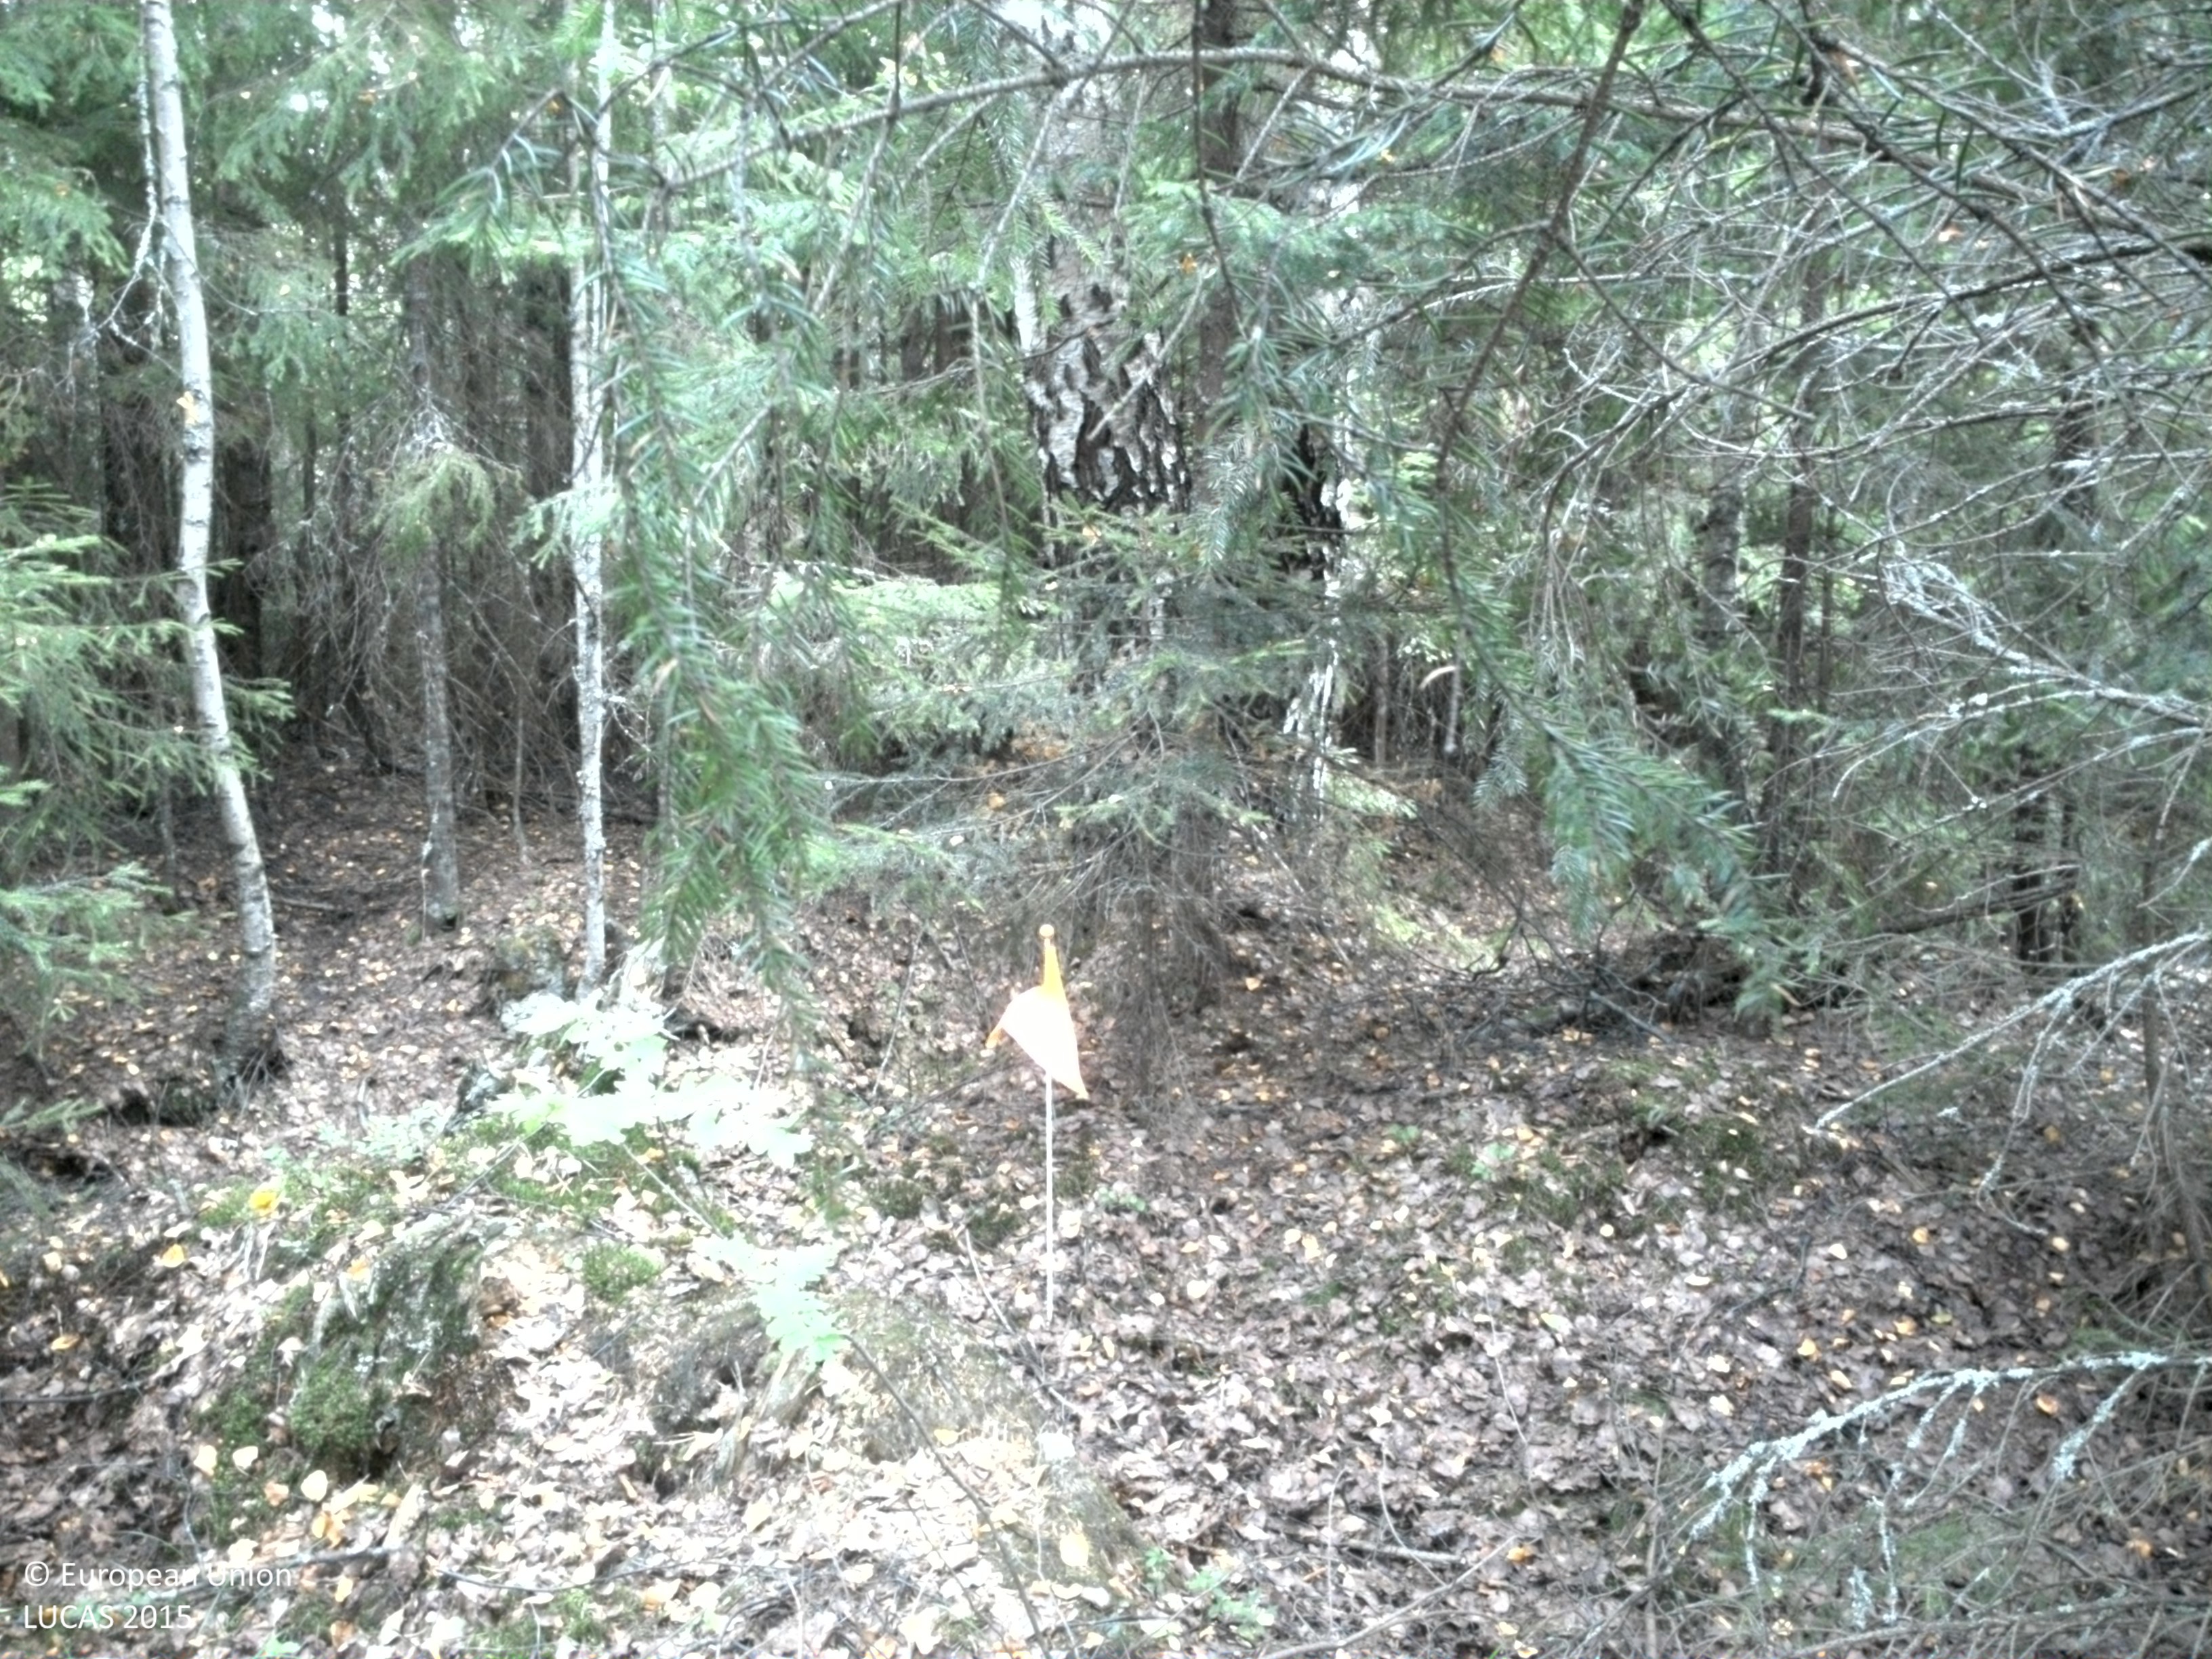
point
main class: Woodland
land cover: Spruce dominated mixed woodland
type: boreal forest
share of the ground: > 75 %
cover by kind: coniferous forest trees 55 %, broadleaved forest trees 25 %, lichens and mosses 5 %
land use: Forestry
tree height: > 5 m
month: August
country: SE
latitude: 59.8660
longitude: 15.7225
